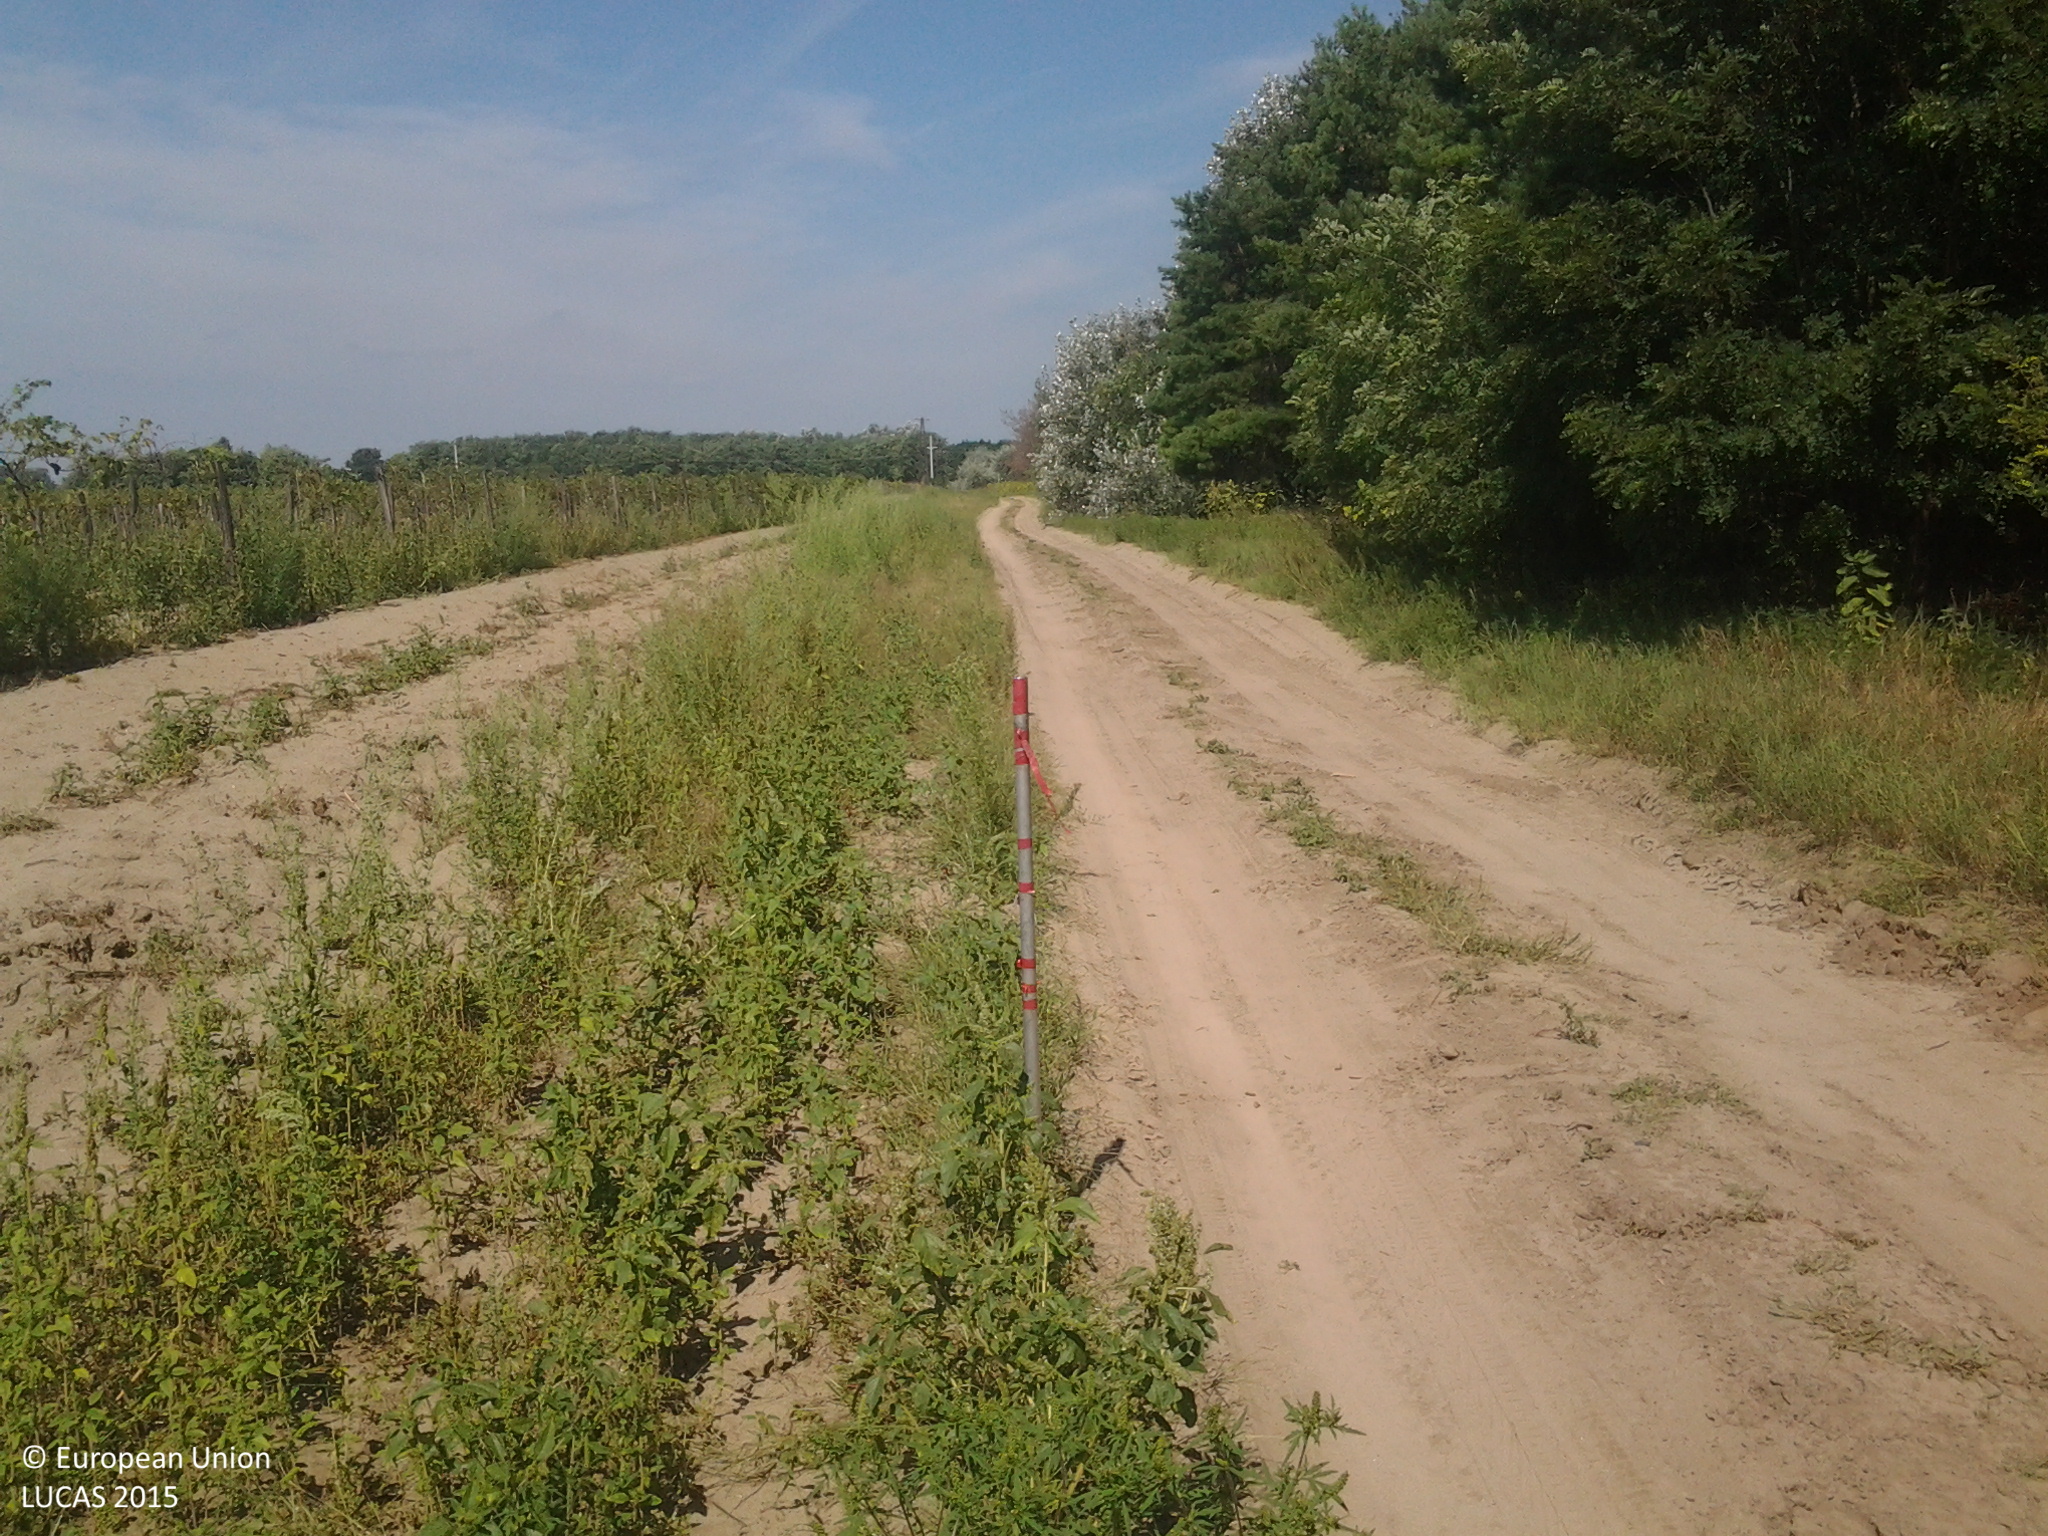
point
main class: Woodland
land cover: Pine dominated coniferous woodland
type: hemiboreal forest and nemoral coniferous forest and mixed broadleaved-coniferous forest
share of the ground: > 75 %
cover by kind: coniferous forest trees 100 %
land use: Forestry
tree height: > 5 m
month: August
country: HU
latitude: 46.7310
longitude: 19.6375
